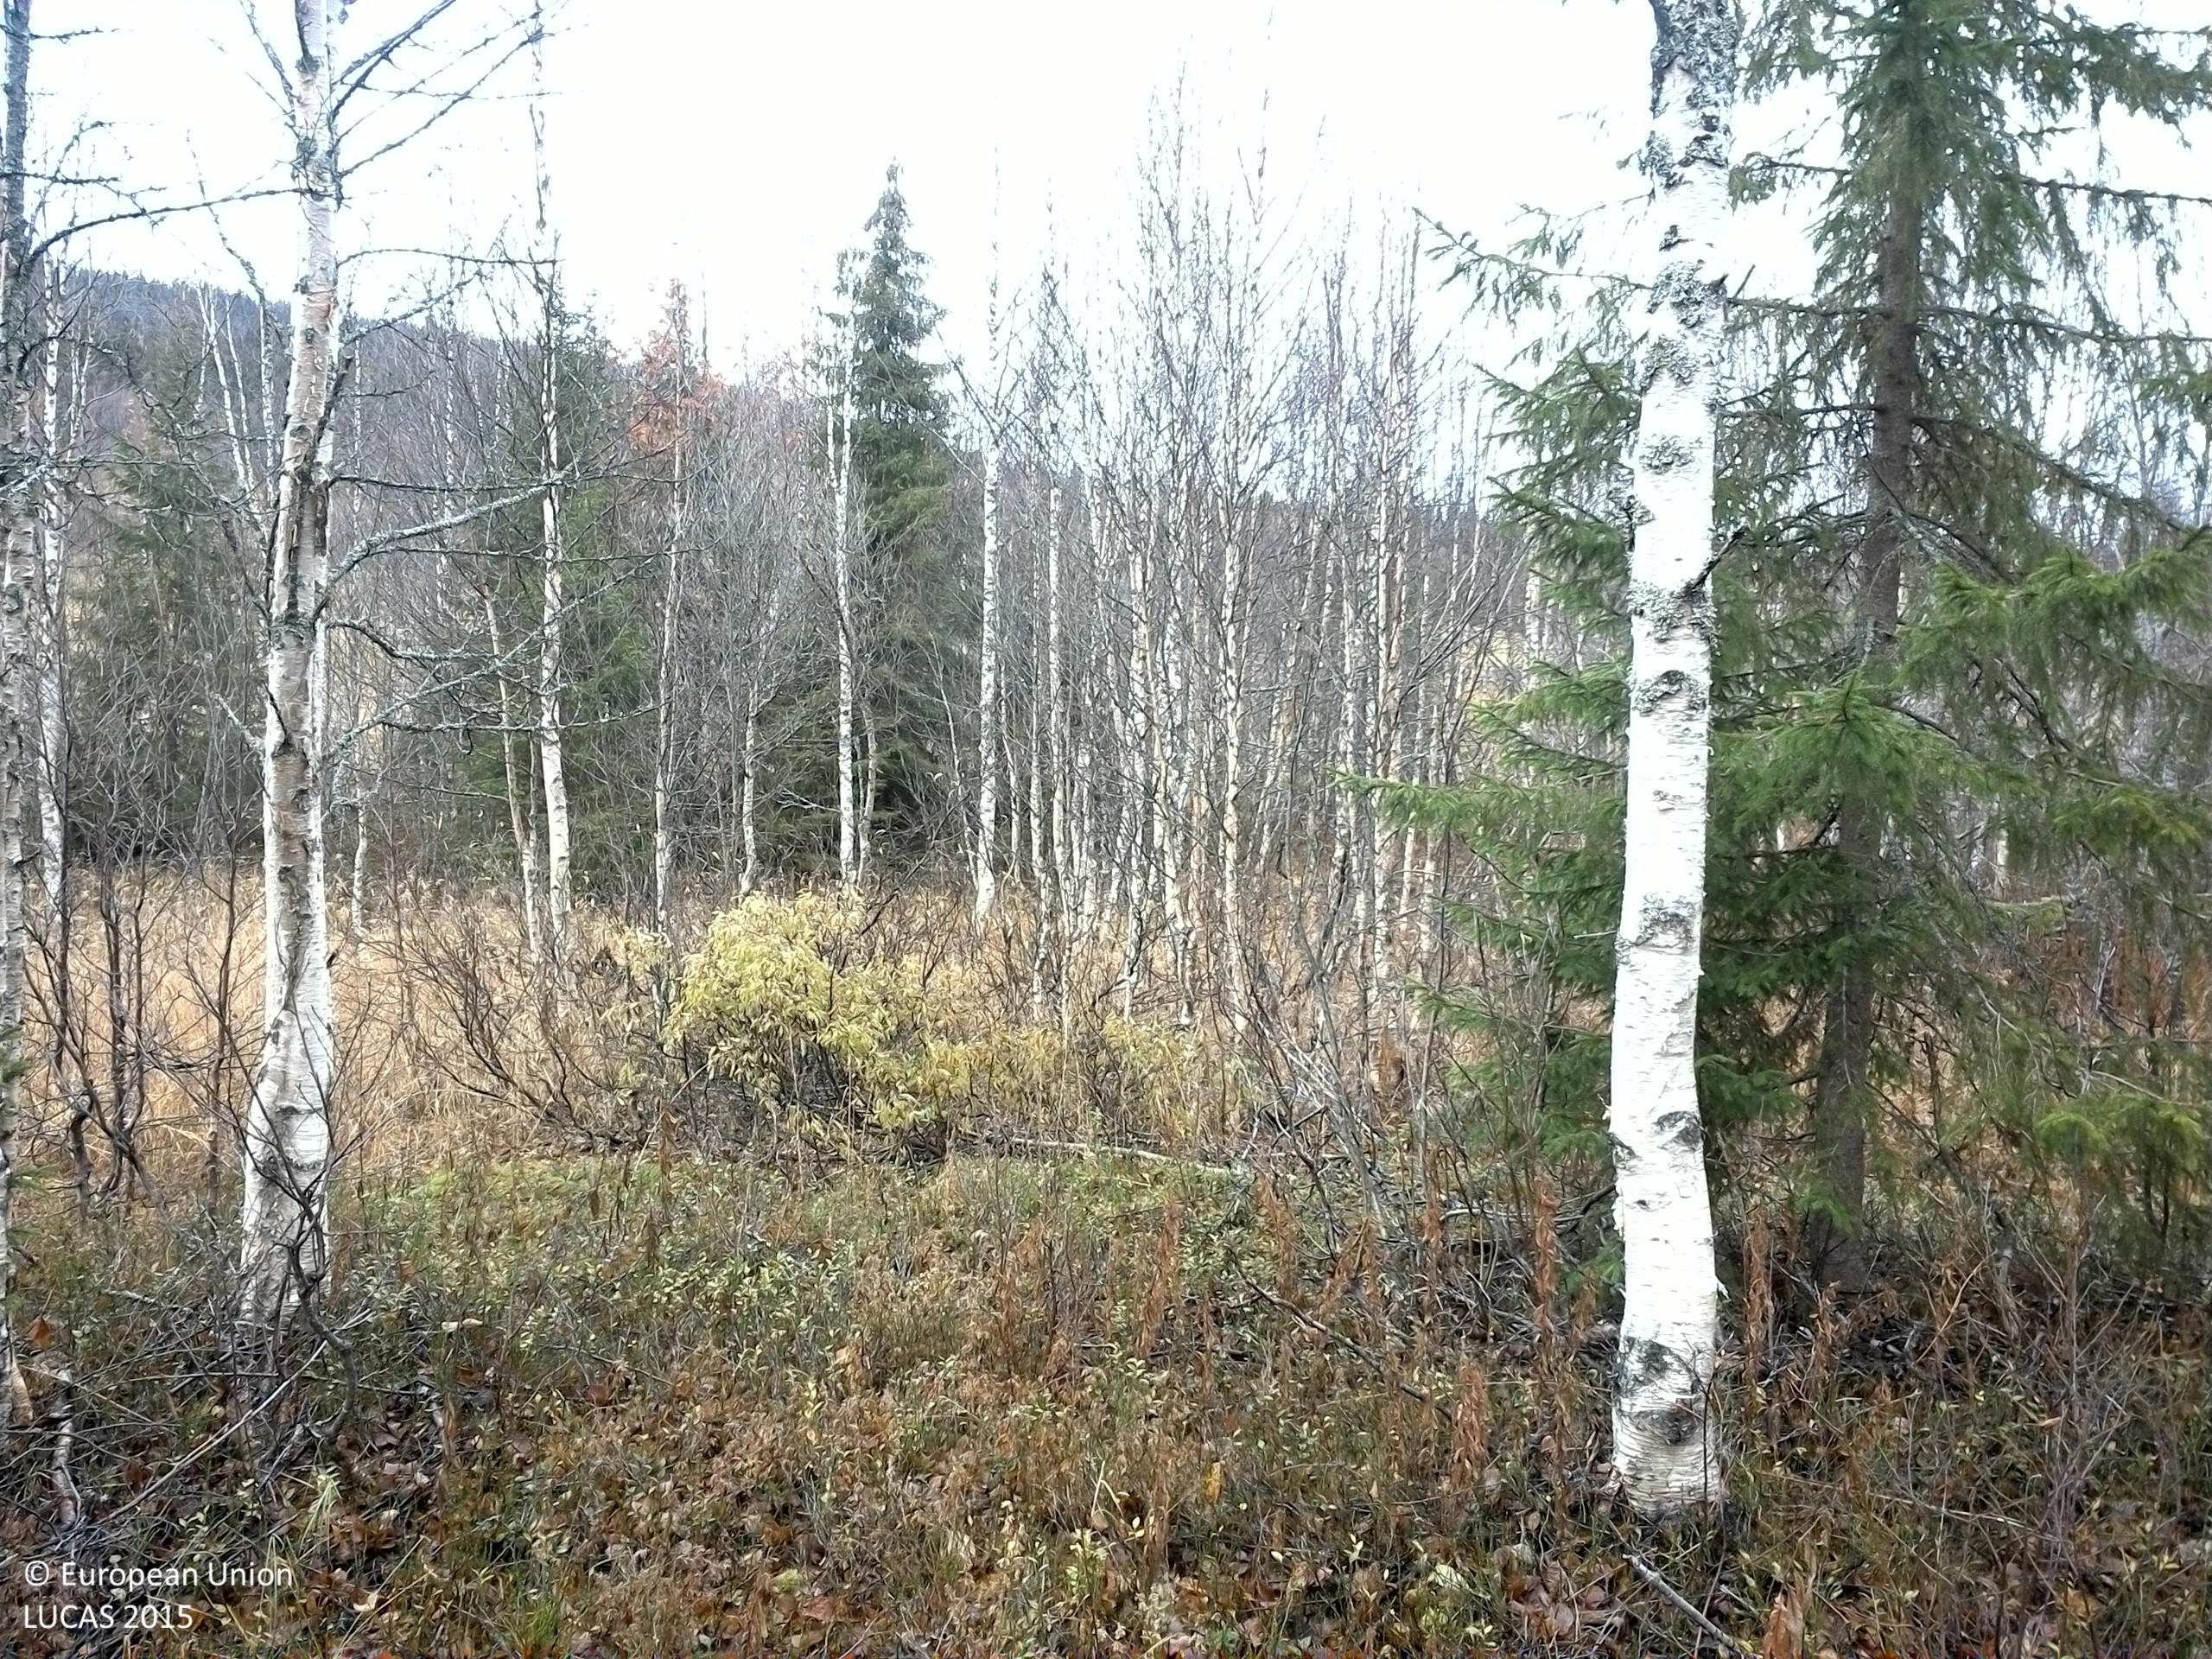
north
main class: Woodland
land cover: Spruce dominated mixed woodland
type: boreal forest
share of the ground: 50 - 75 %
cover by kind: broadleaved forest trees 55 %, coniferous forest trees 20 %, shrubs 15 %, lichens and mosses 10 %
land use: Forestry
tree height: > 5 m
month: October
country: SE
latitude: 64.7277
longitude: 13.9848
